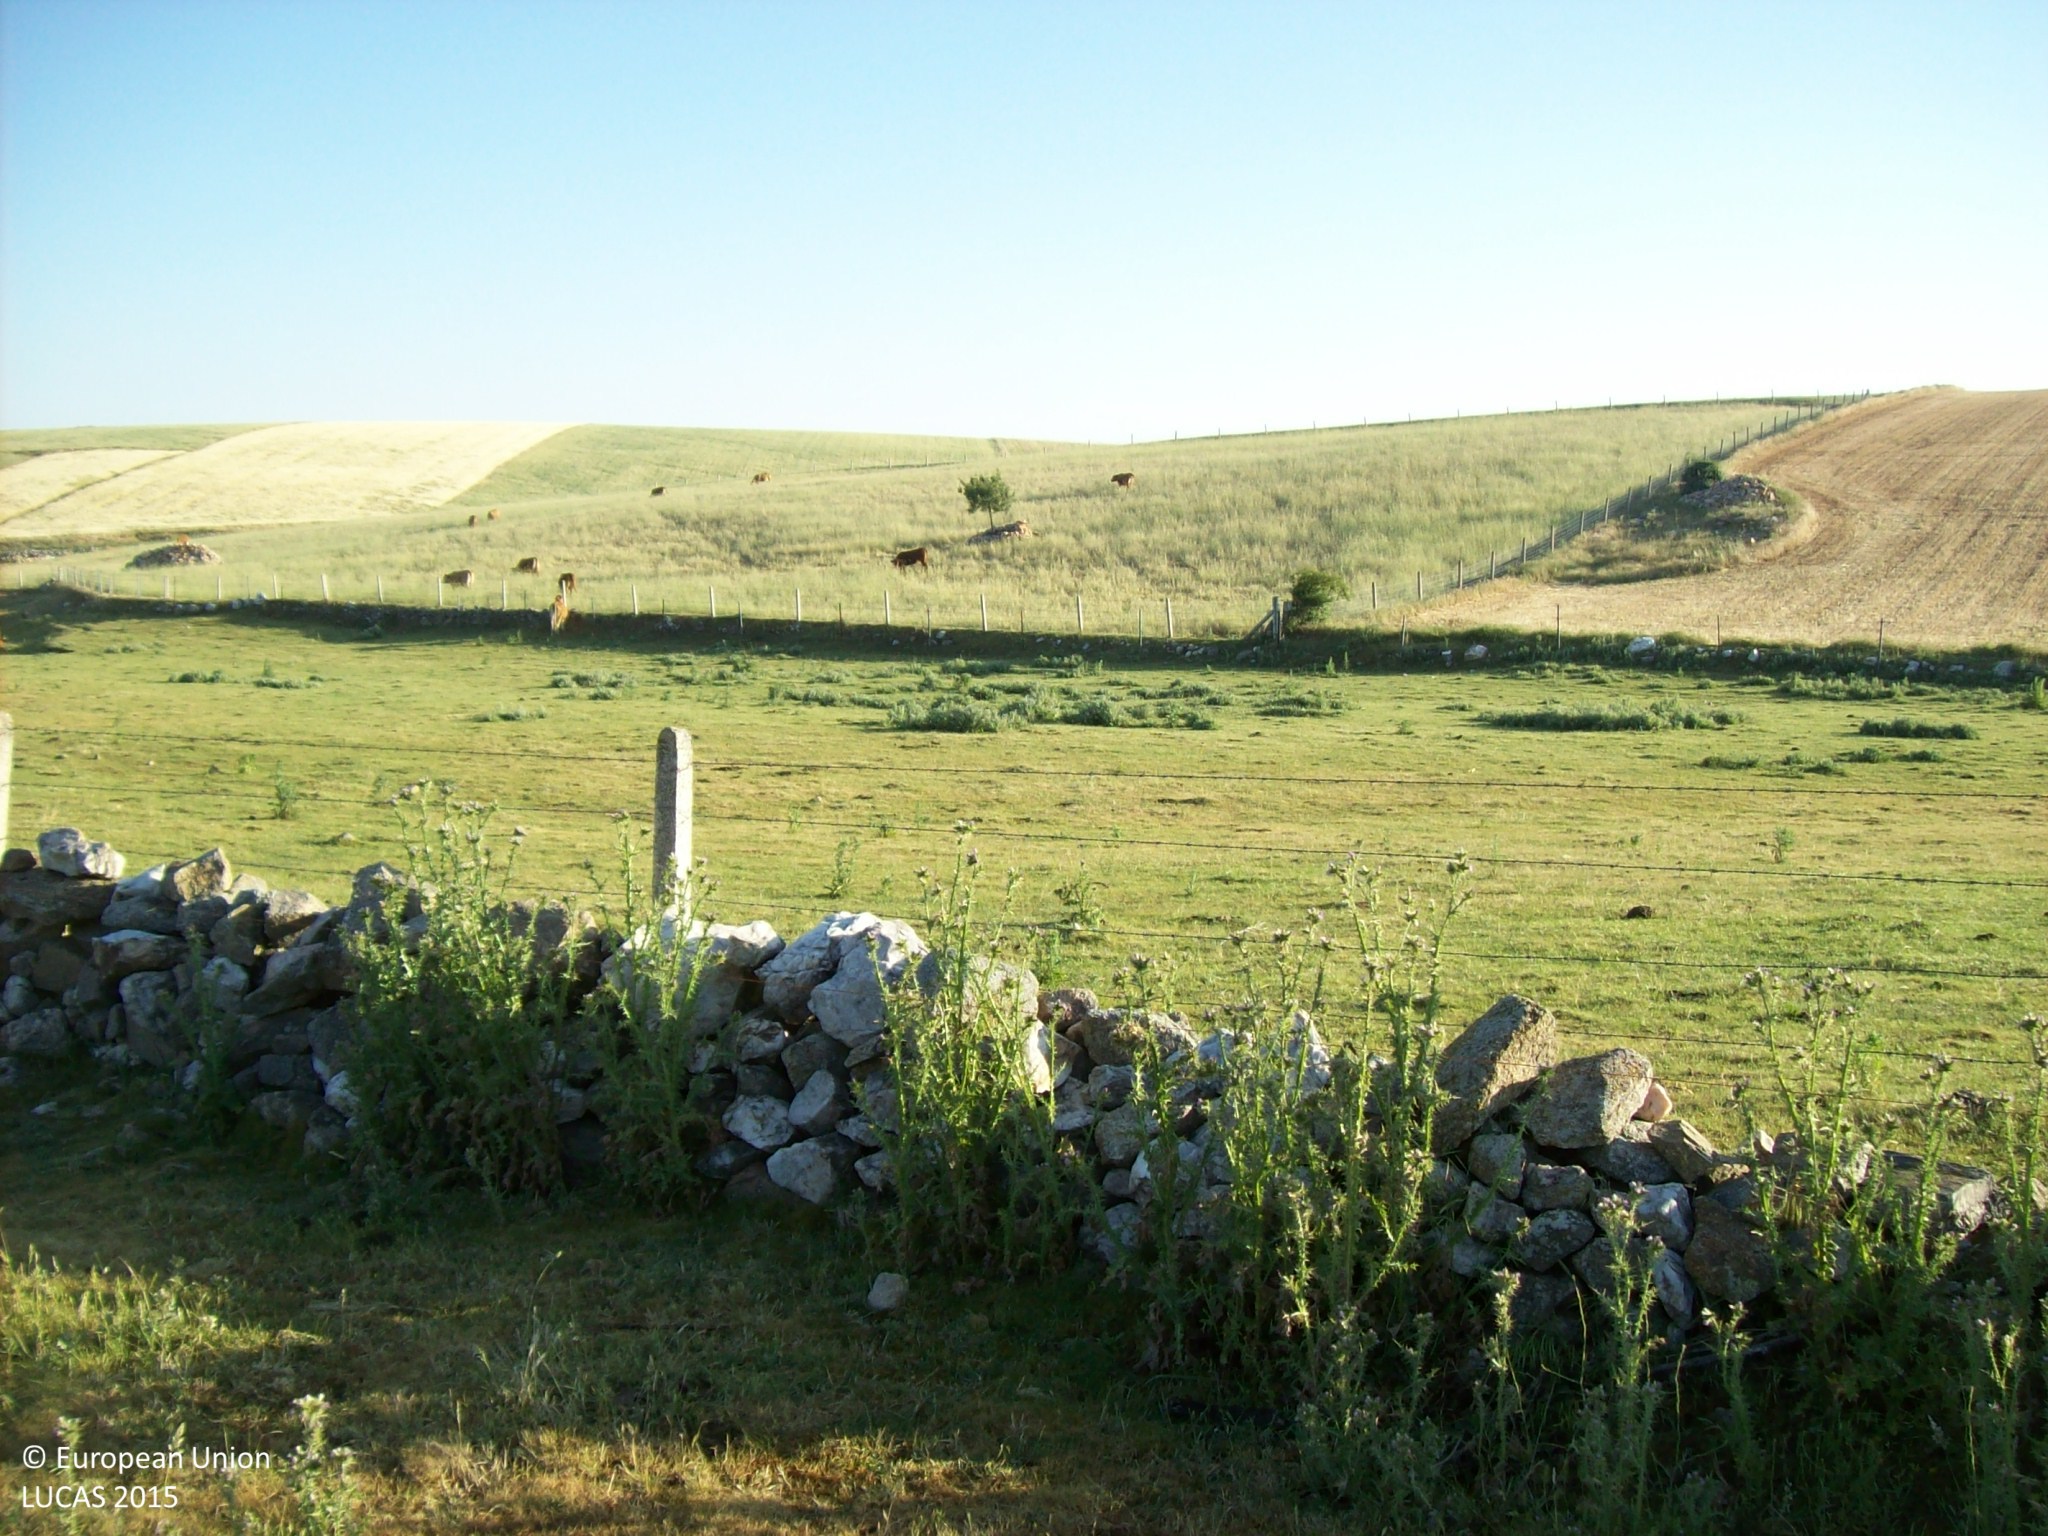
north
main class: Grassland
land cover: Grassland without tree/shrub cover
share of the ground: > 75 %
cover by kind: herbaceous plants 100 %
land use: Agriculture (excluding fallow land and kitchen gardens)
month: May
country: ES
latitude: 40.7591
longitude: -5.1197
